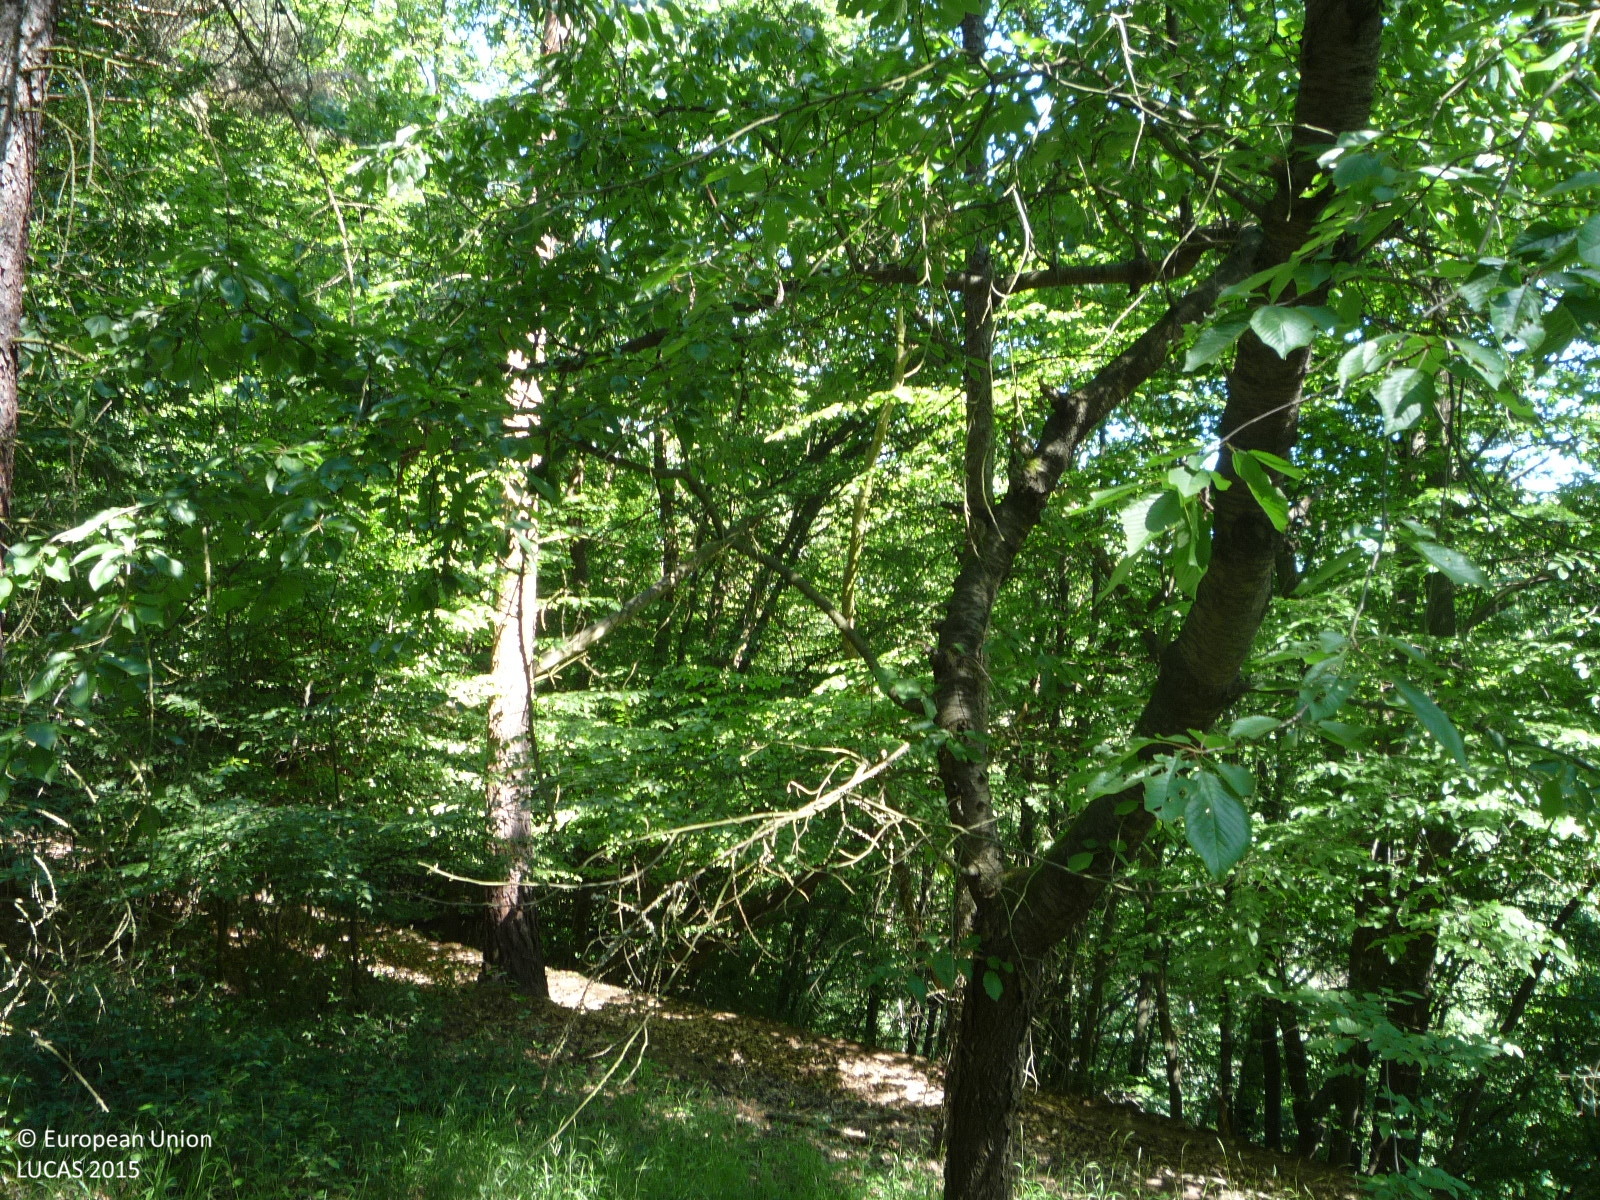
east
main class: Woodland
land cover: Other coniferous woodland
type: hemiboreal forest and nemoral coniferous forest and mixed broadleaved-coniferous forest
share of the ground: > 75 %
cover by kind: coniferous forest trees 90 %, broadleaved forest trees 5 %, herbaceous plants 5 %
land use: Forestry
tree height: > 5 m
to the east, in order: Other coniferous woodland; Broadleaved woodland; Rock outcrops; Broadleaved woodland; Pine dominated mixed woodland
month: July
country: CZ
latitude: 50.4727
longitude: 14.5248
